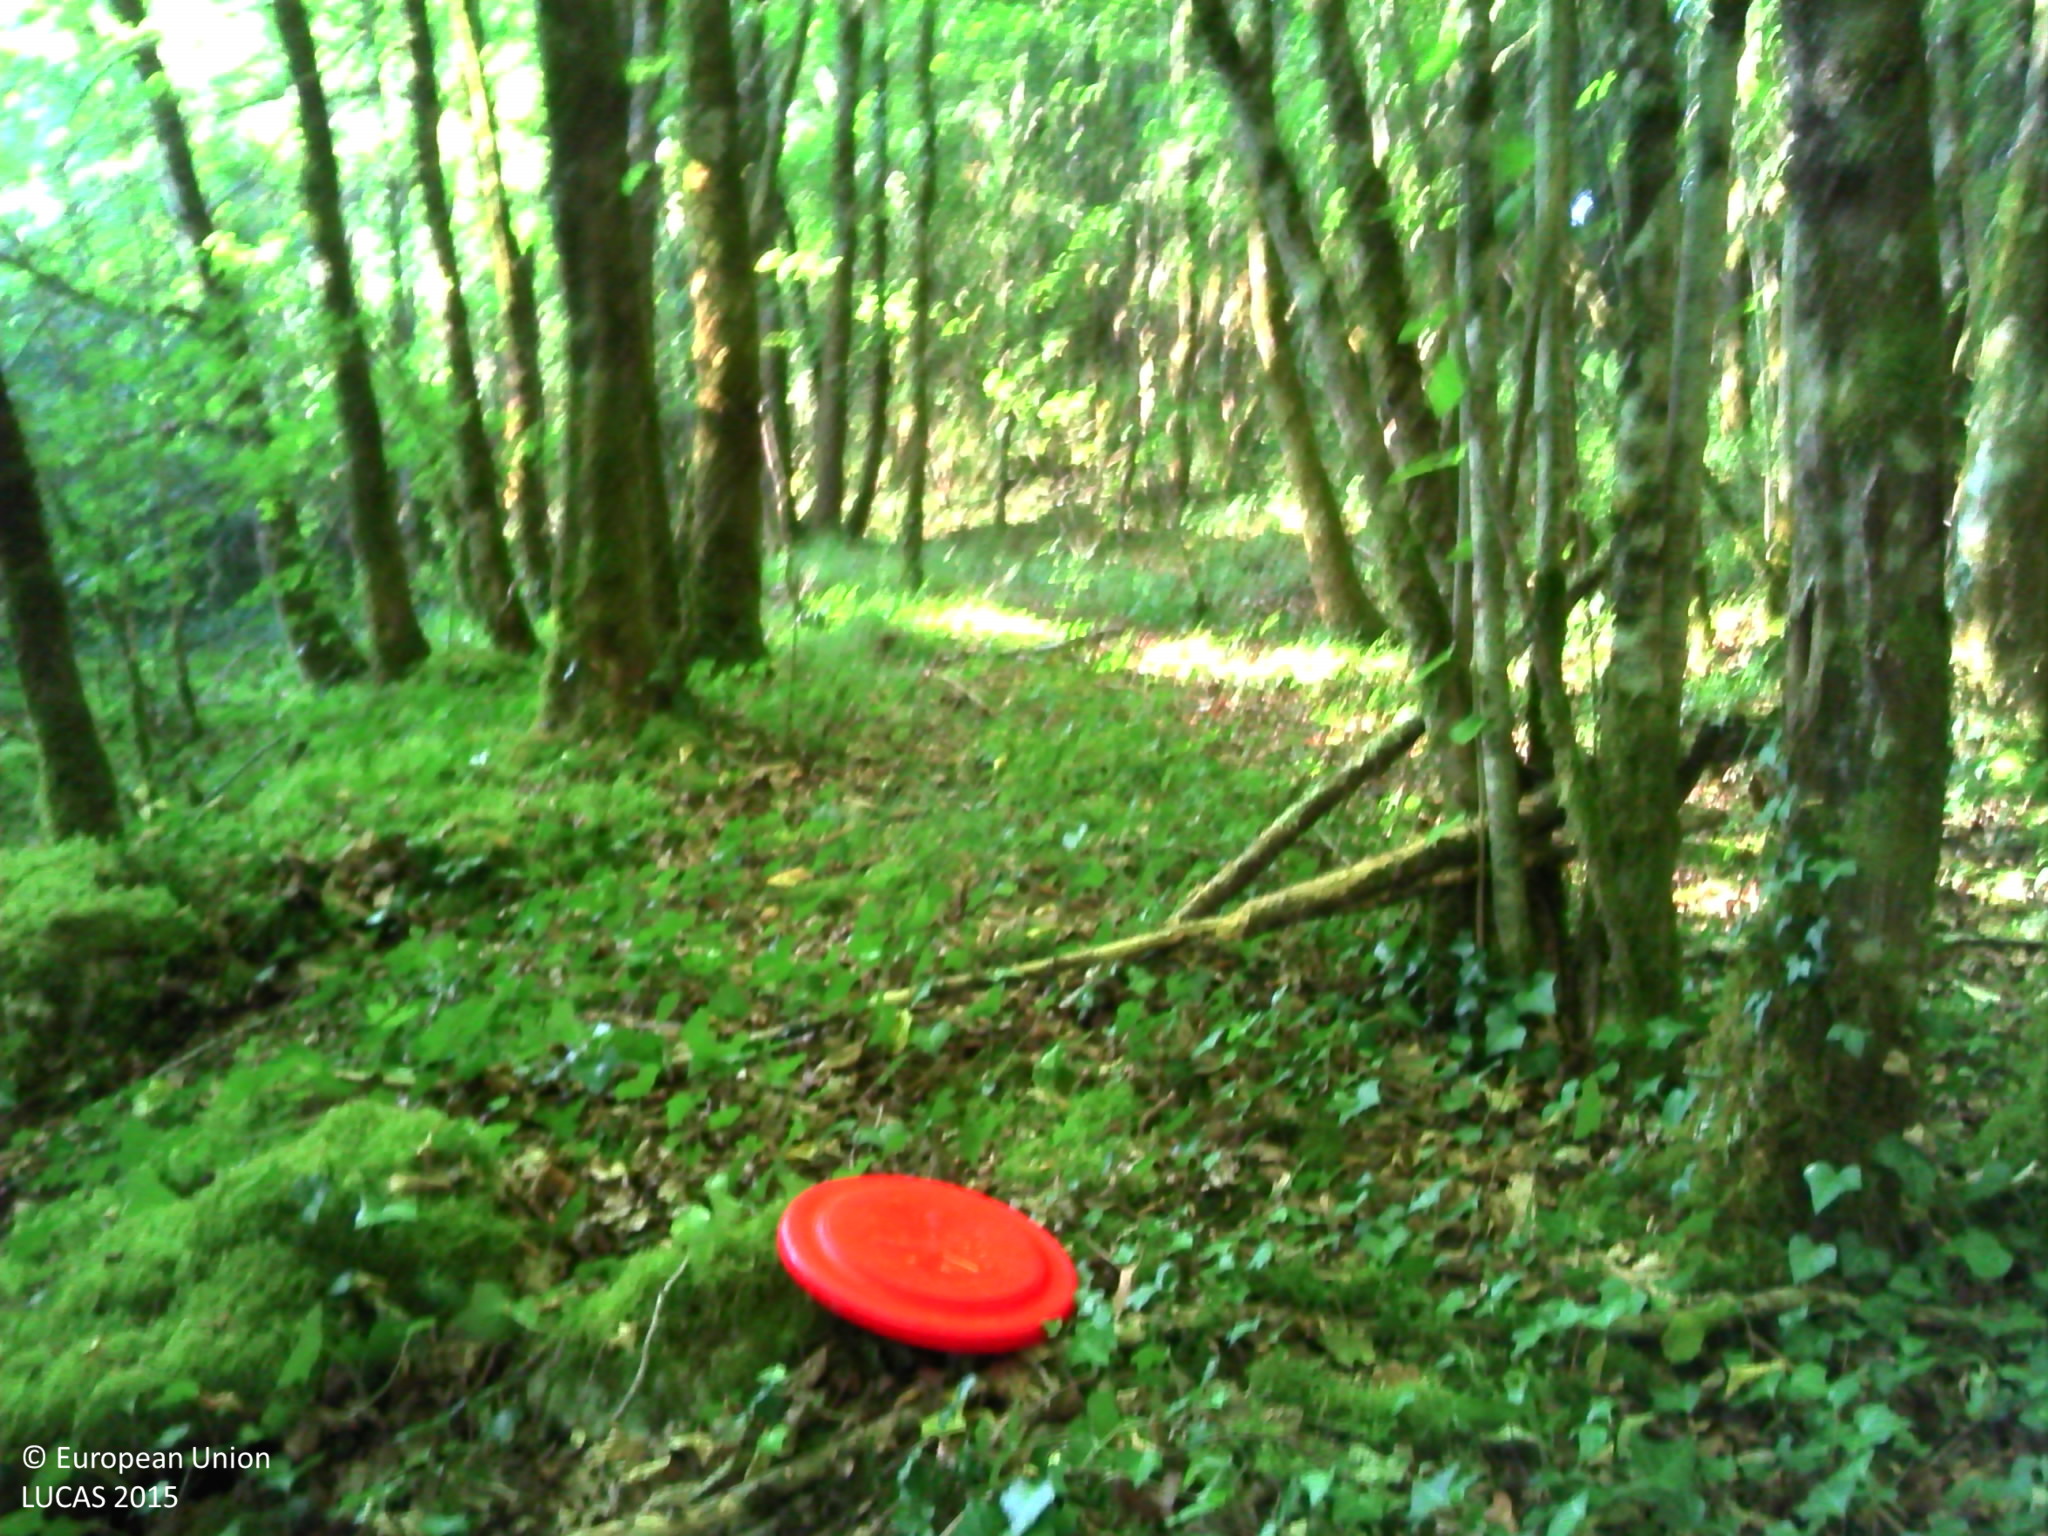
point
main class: Woodland
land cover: Broadleaved woodland
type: acidophilous oak and oak-birch forest
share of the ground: > 75 %
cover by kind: broadleaved forest trees 80 %, shrubs 10 %, herbaceous plants 5 %, lichens and mosses 5 %
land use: Forestry
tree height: > 5 m
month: July
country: FR
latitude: 45.3229
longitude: 1.0485
